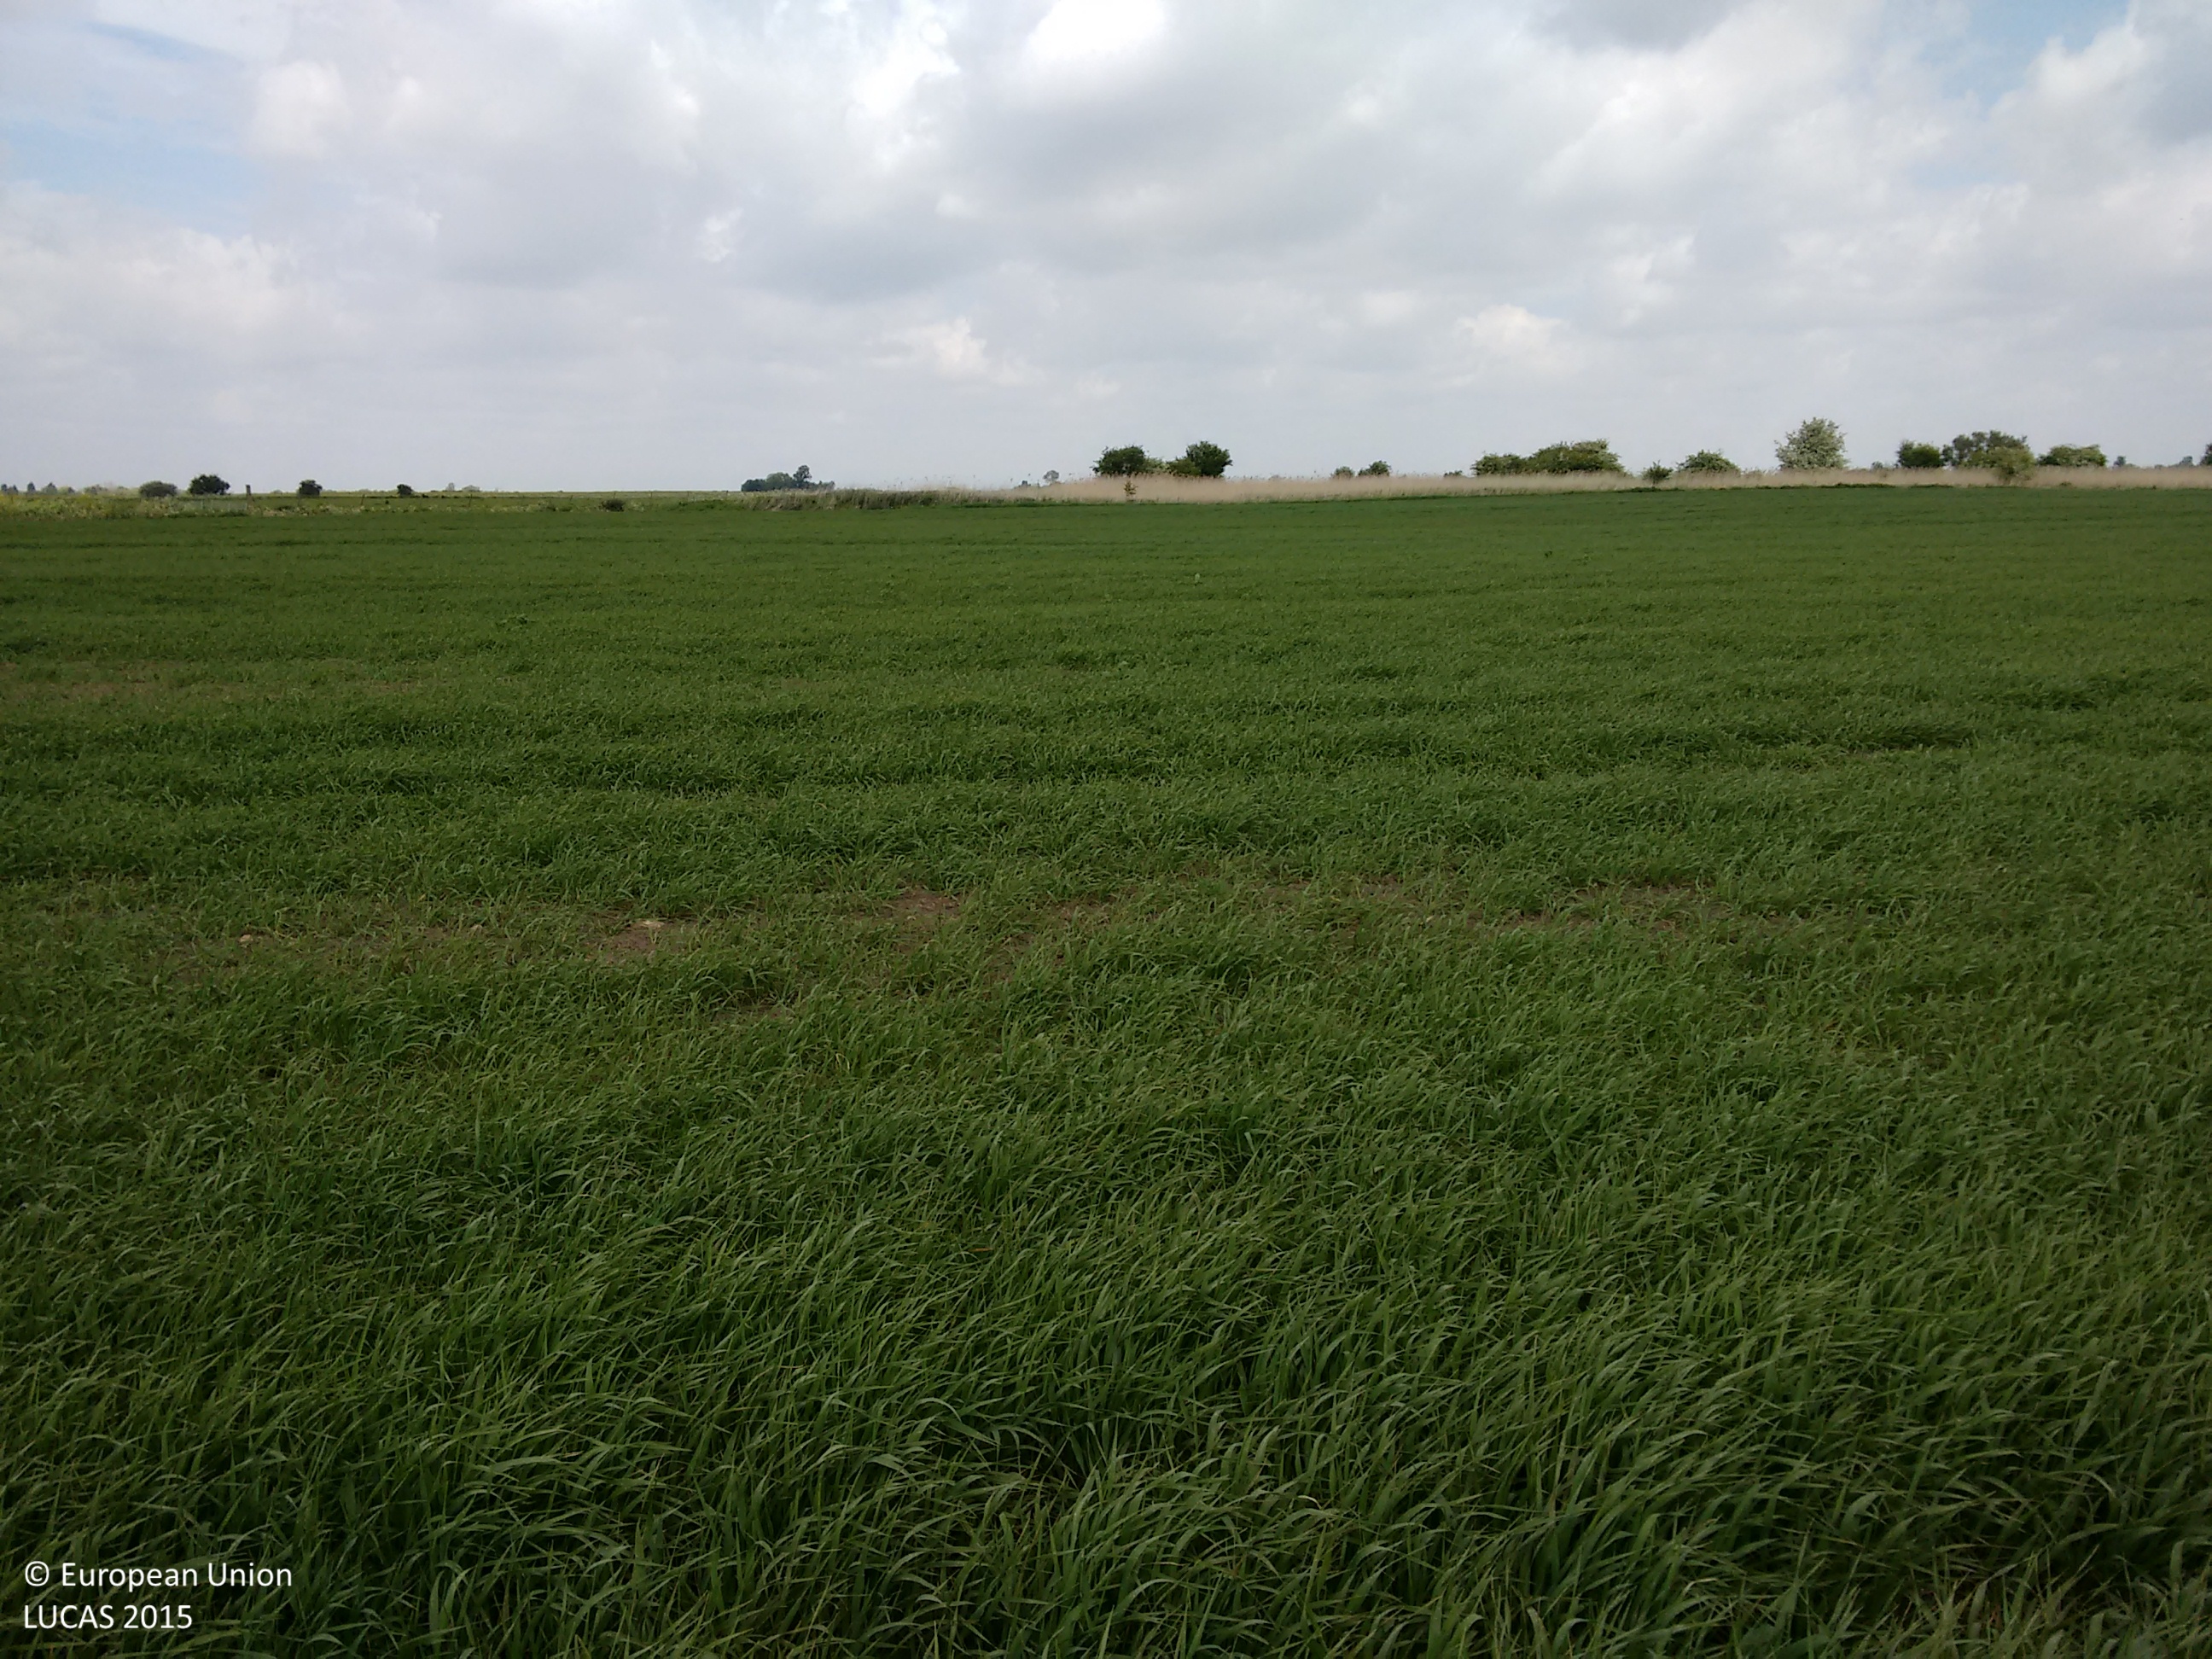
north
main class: Cropland
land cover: Barley
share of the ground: > 75 %
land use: Agriculture (excluding fallow land and kitchen gardens)
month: May
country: GB
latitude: 52.7132
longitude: -0.0244
